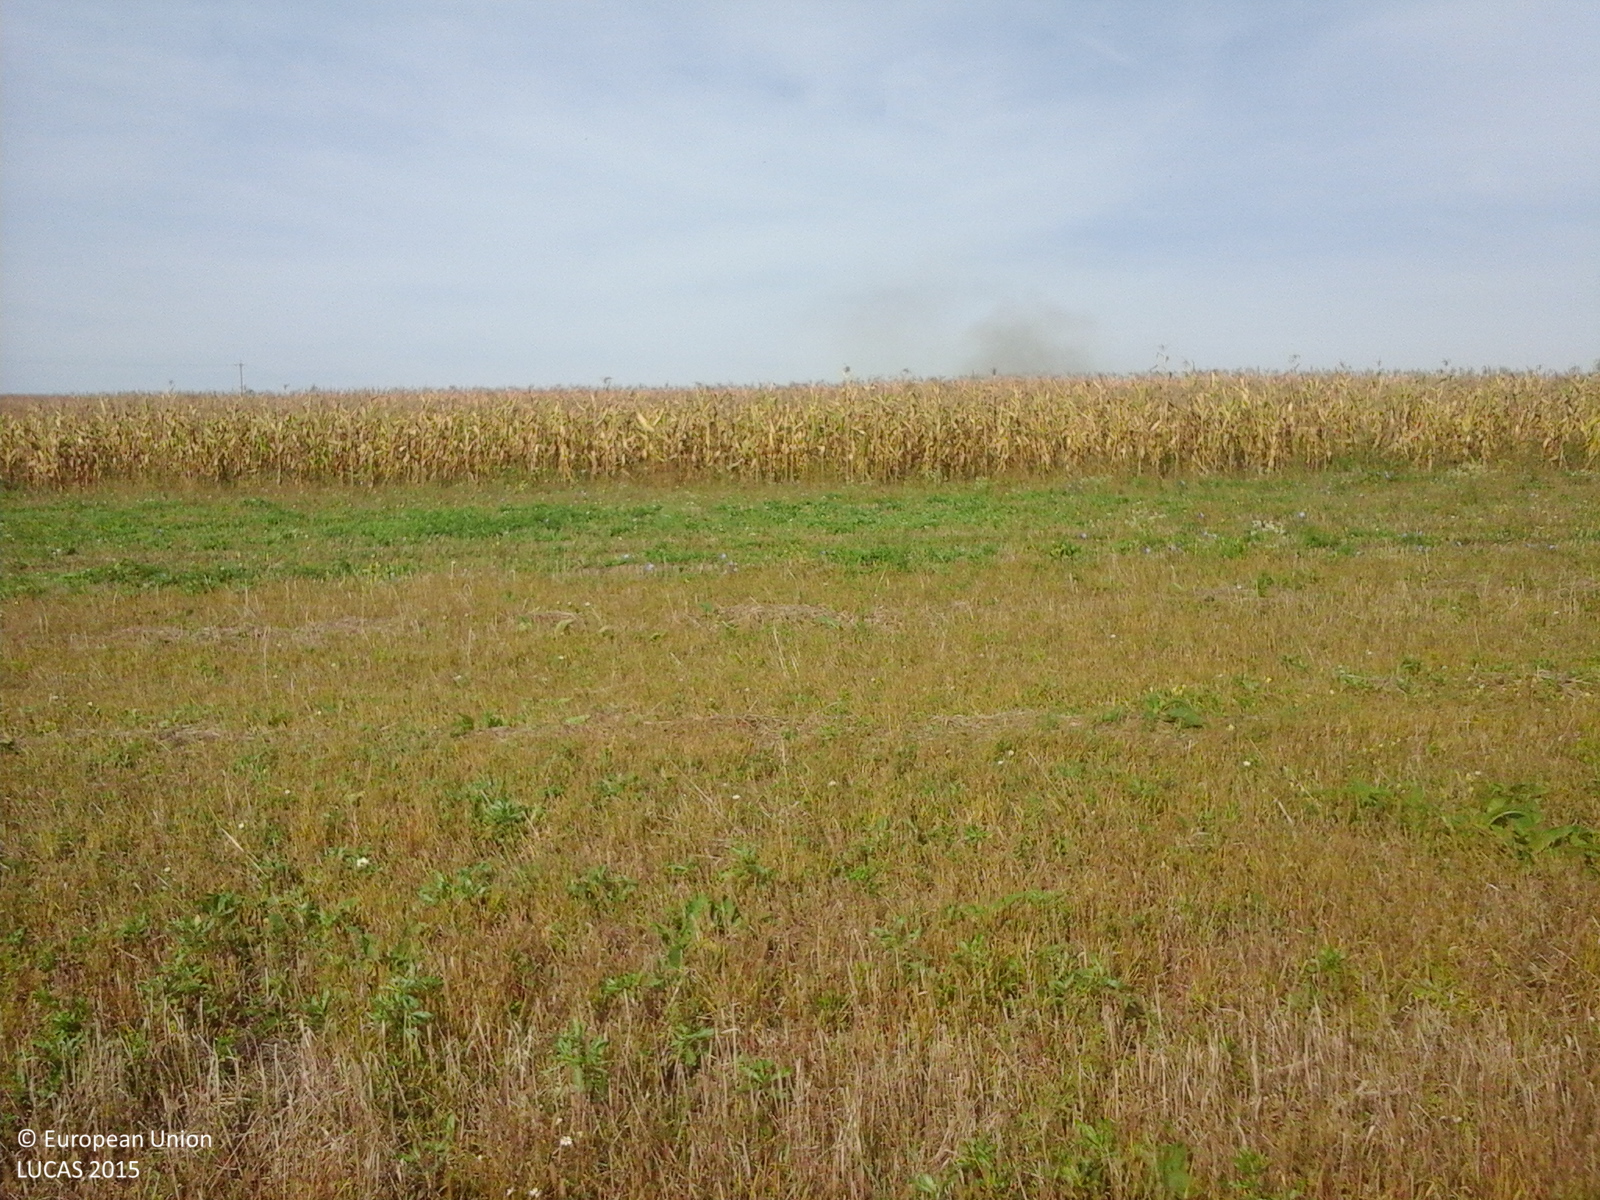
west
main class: Cropland
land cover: Maize
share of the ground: > 75 %
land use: Agriculture (excluding fallow land and kitchen gardens)
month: September
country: RO
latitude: 46.9235
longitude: 23.4247
